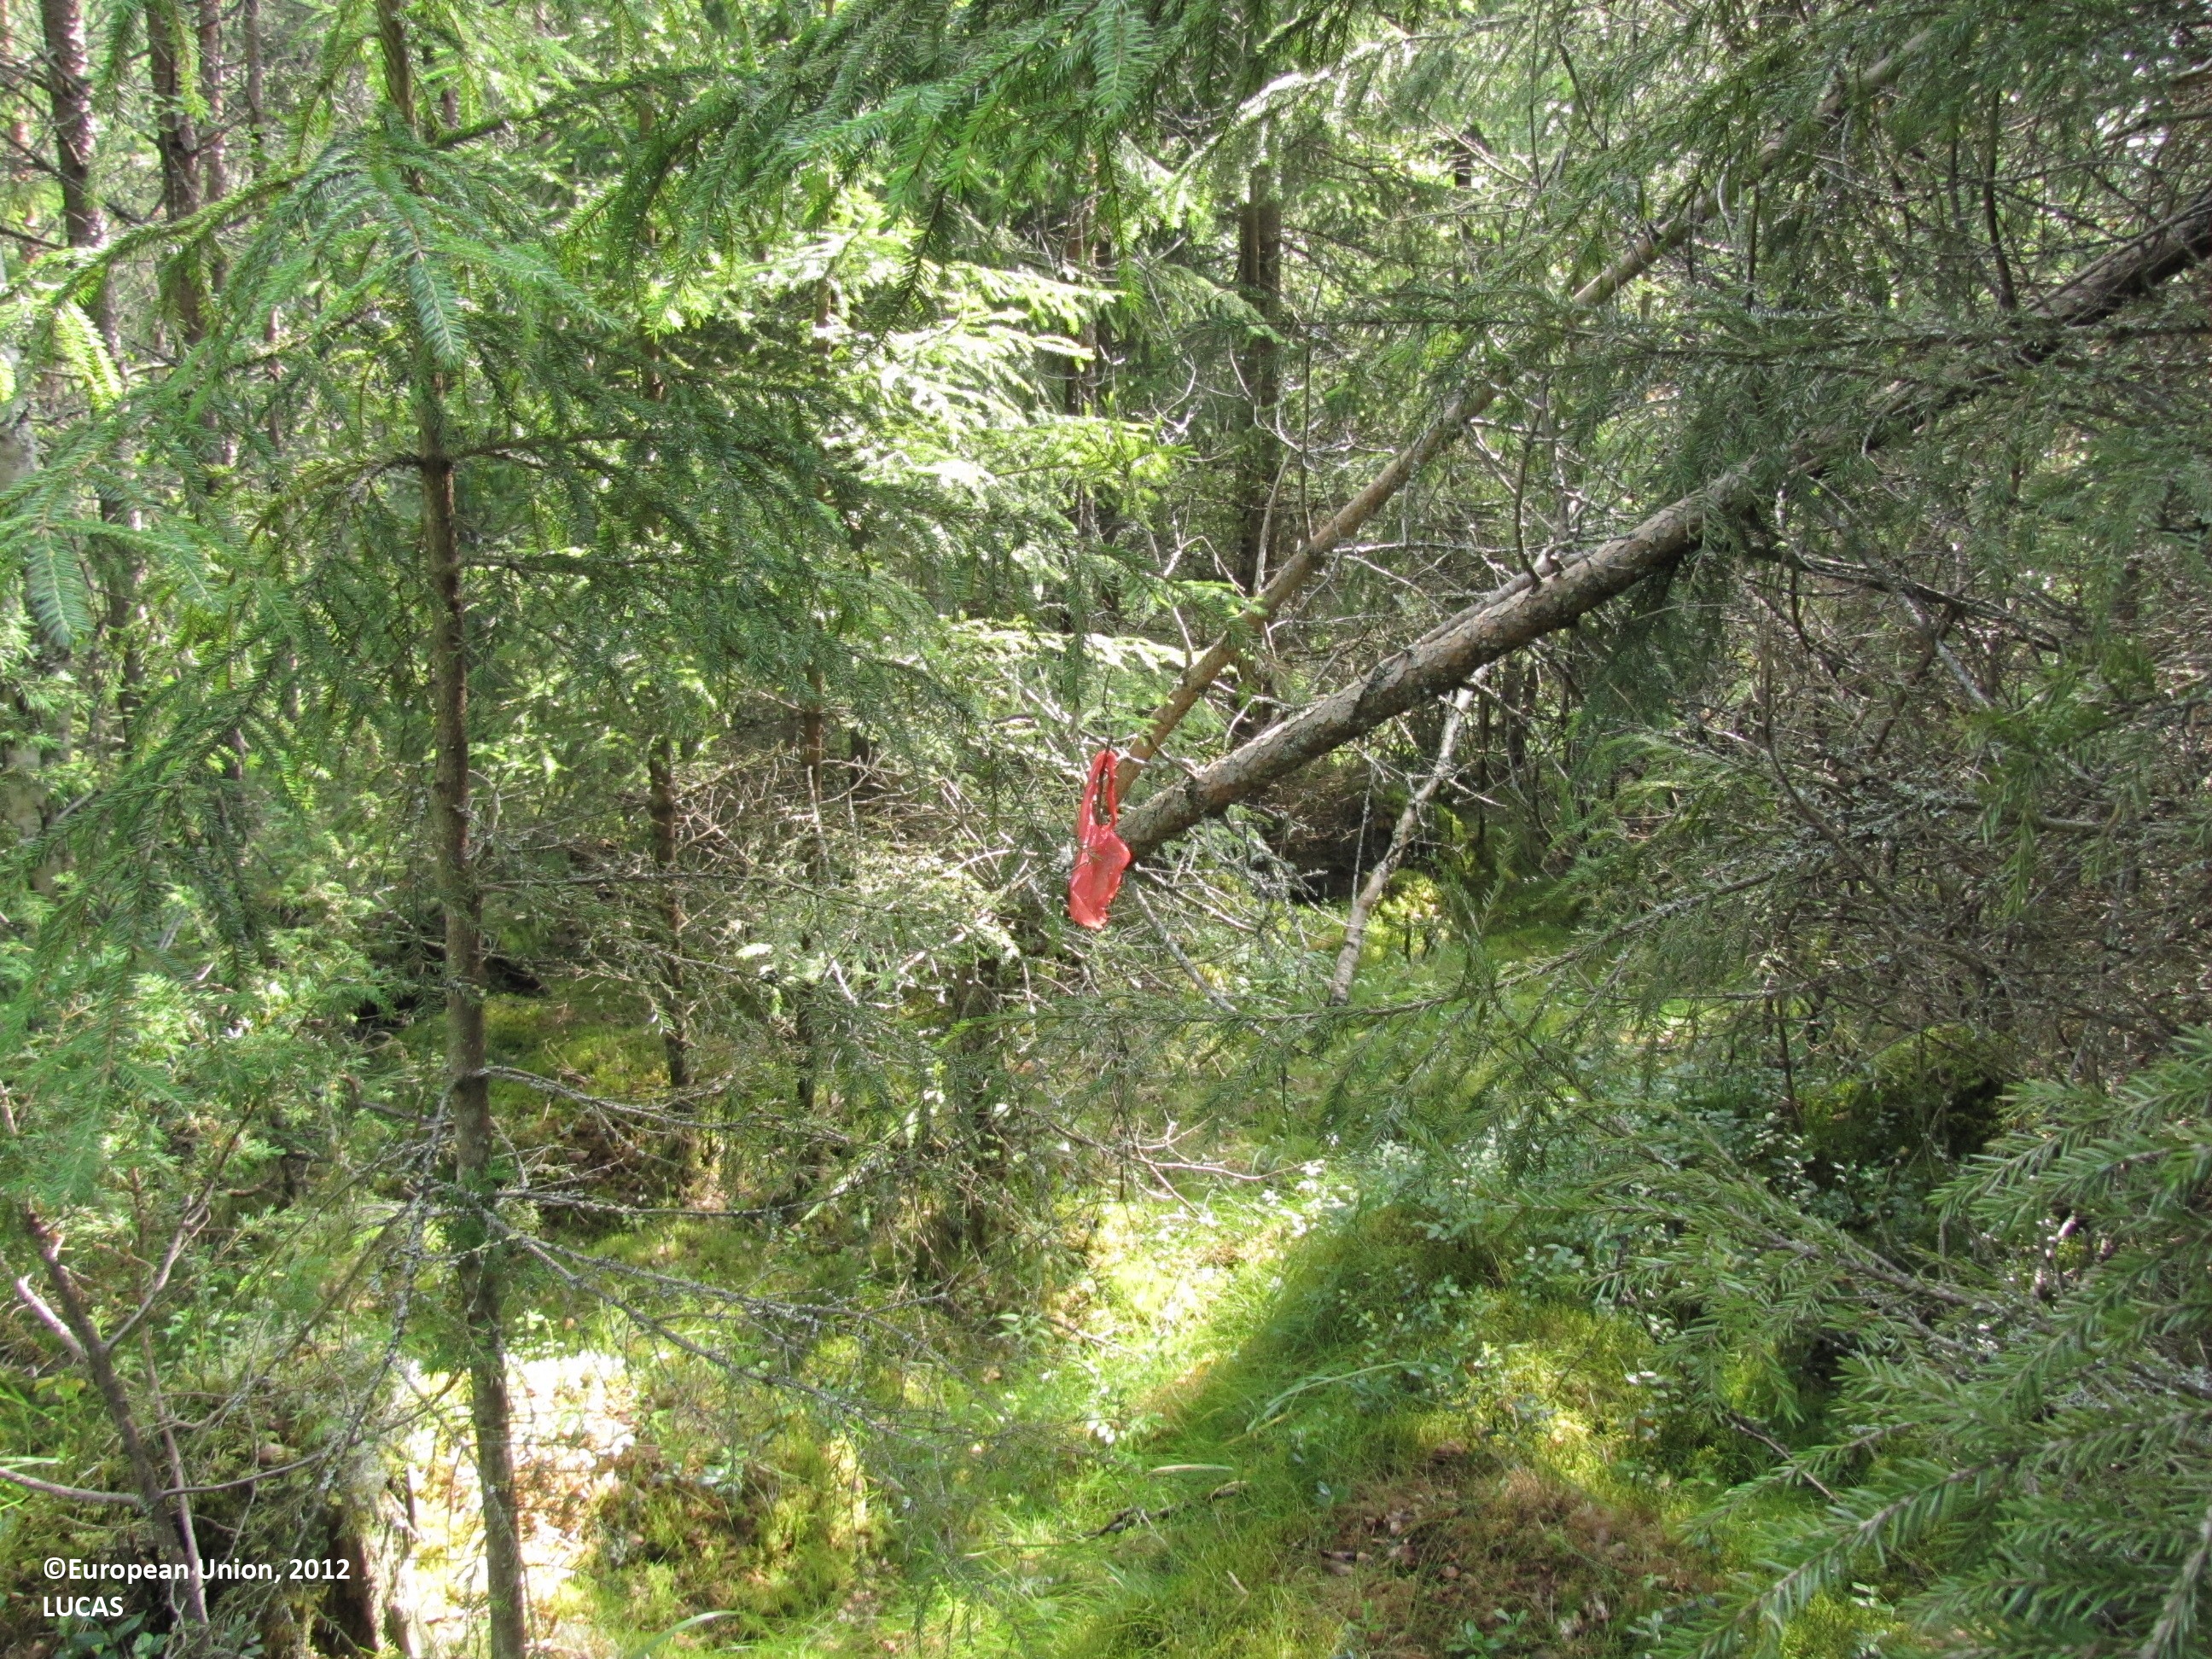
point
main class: Woodland
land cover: Spruce dominated mixed woodland
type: boreal forest
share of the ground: > 75 %
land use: Forestry
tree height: > 5 m
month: July
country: FI
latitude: 61.9650
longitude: 23.2889
